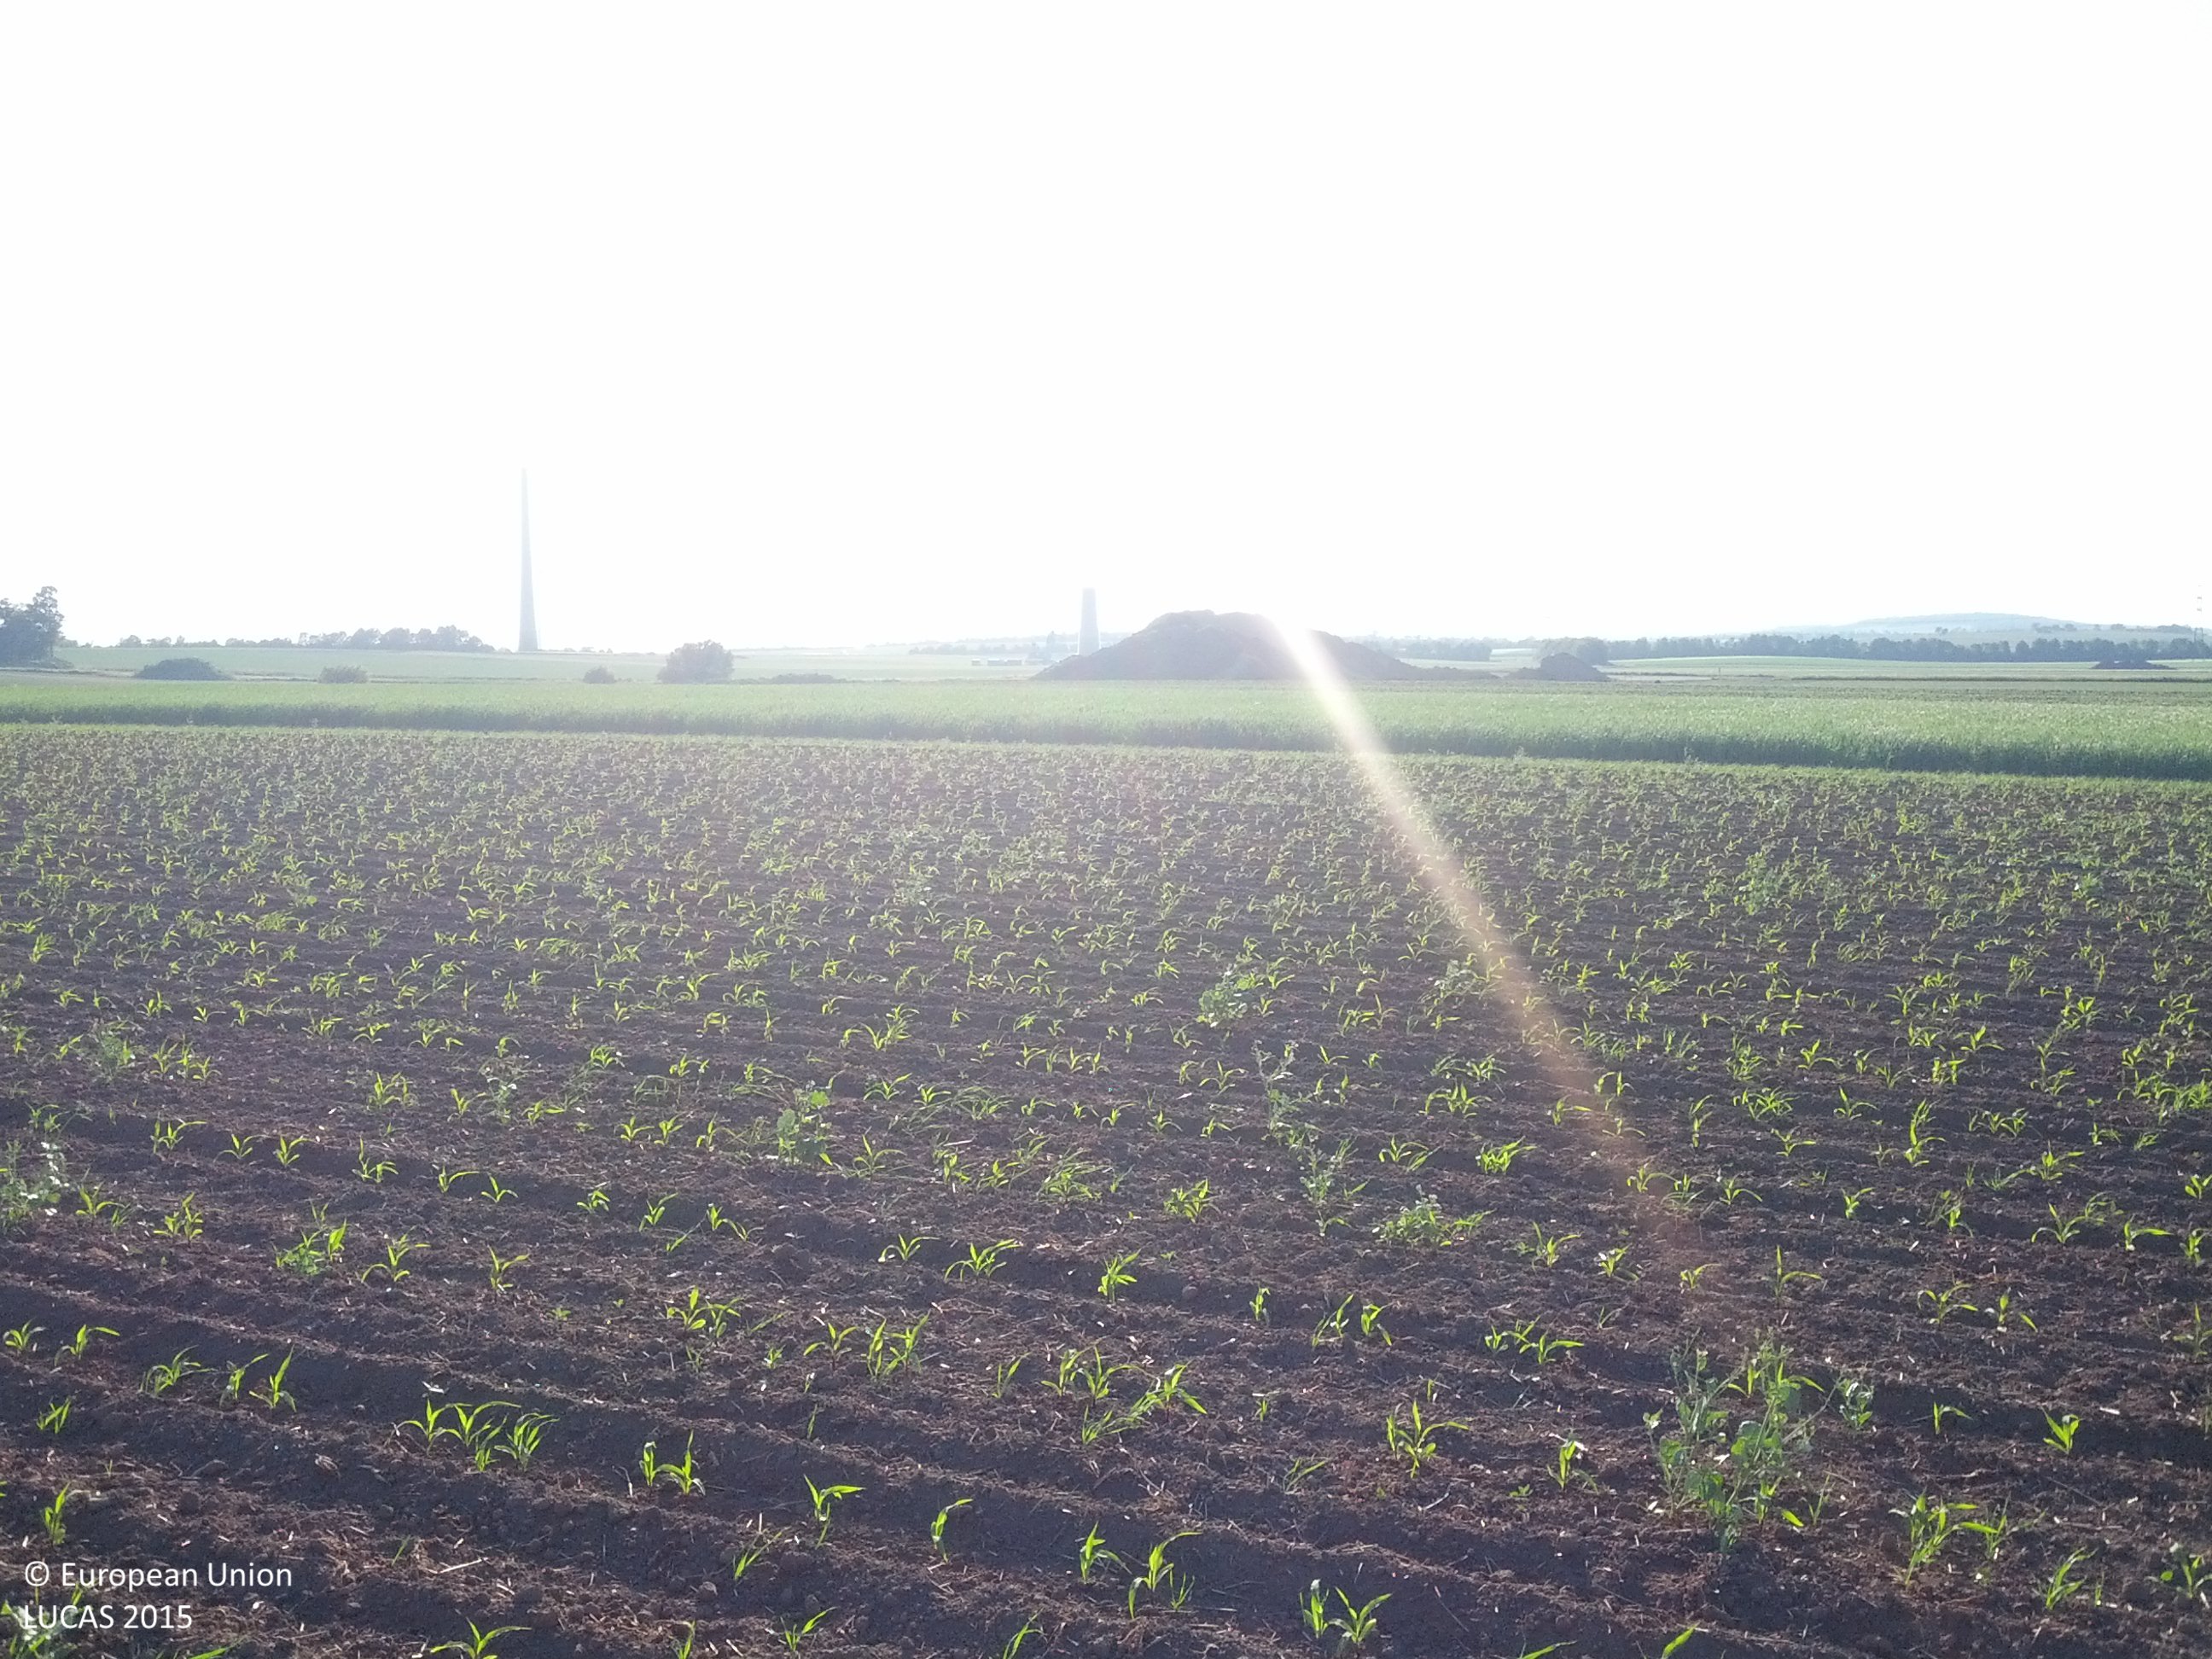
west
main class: Cropland
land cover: Maize
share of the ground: < 10 %
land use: Agriculture (excluding fallow land and kitchen gardens)
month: May
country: AT
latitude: 48.0491
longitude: 16.8079
